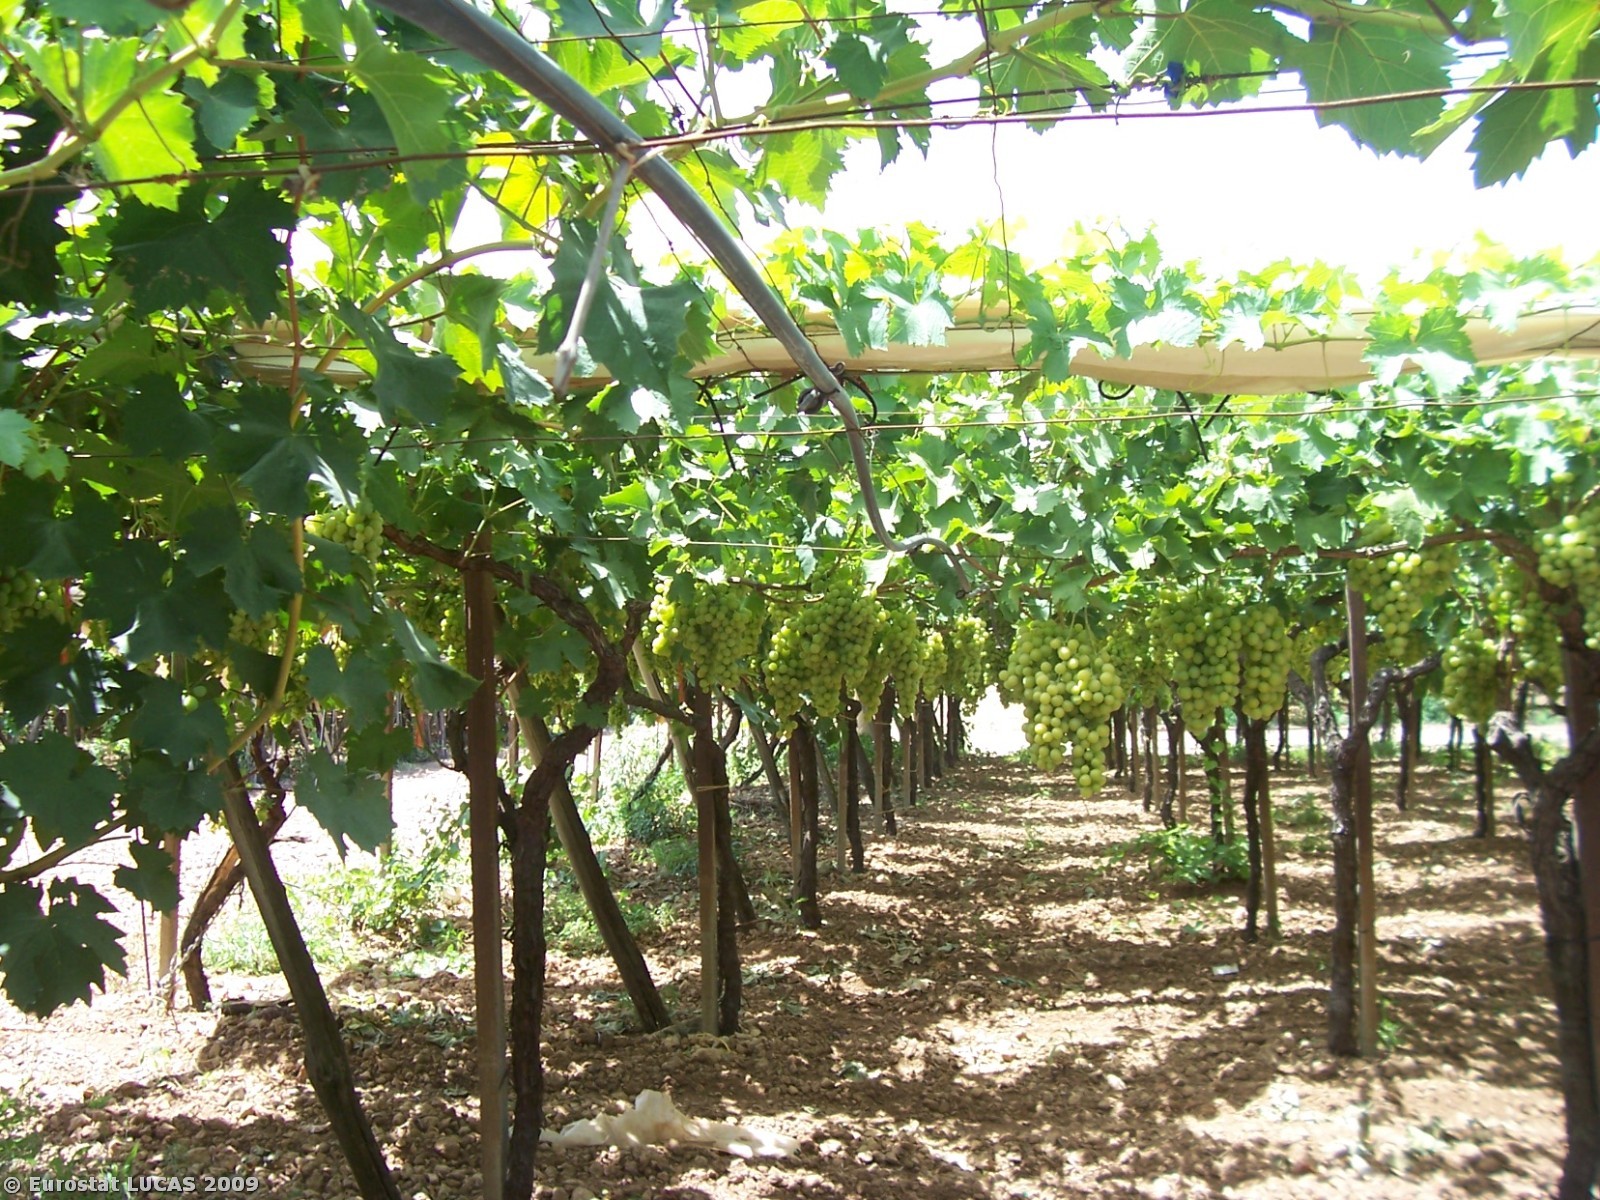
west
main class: Cropland
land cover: Vineyards
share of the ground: > 75 %
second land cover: Bare land
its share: > 75 %
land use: Agriculture (excluding fallow land and kitchen gardens)
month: July
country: IT
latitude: 40.6155
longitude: 17.0094
